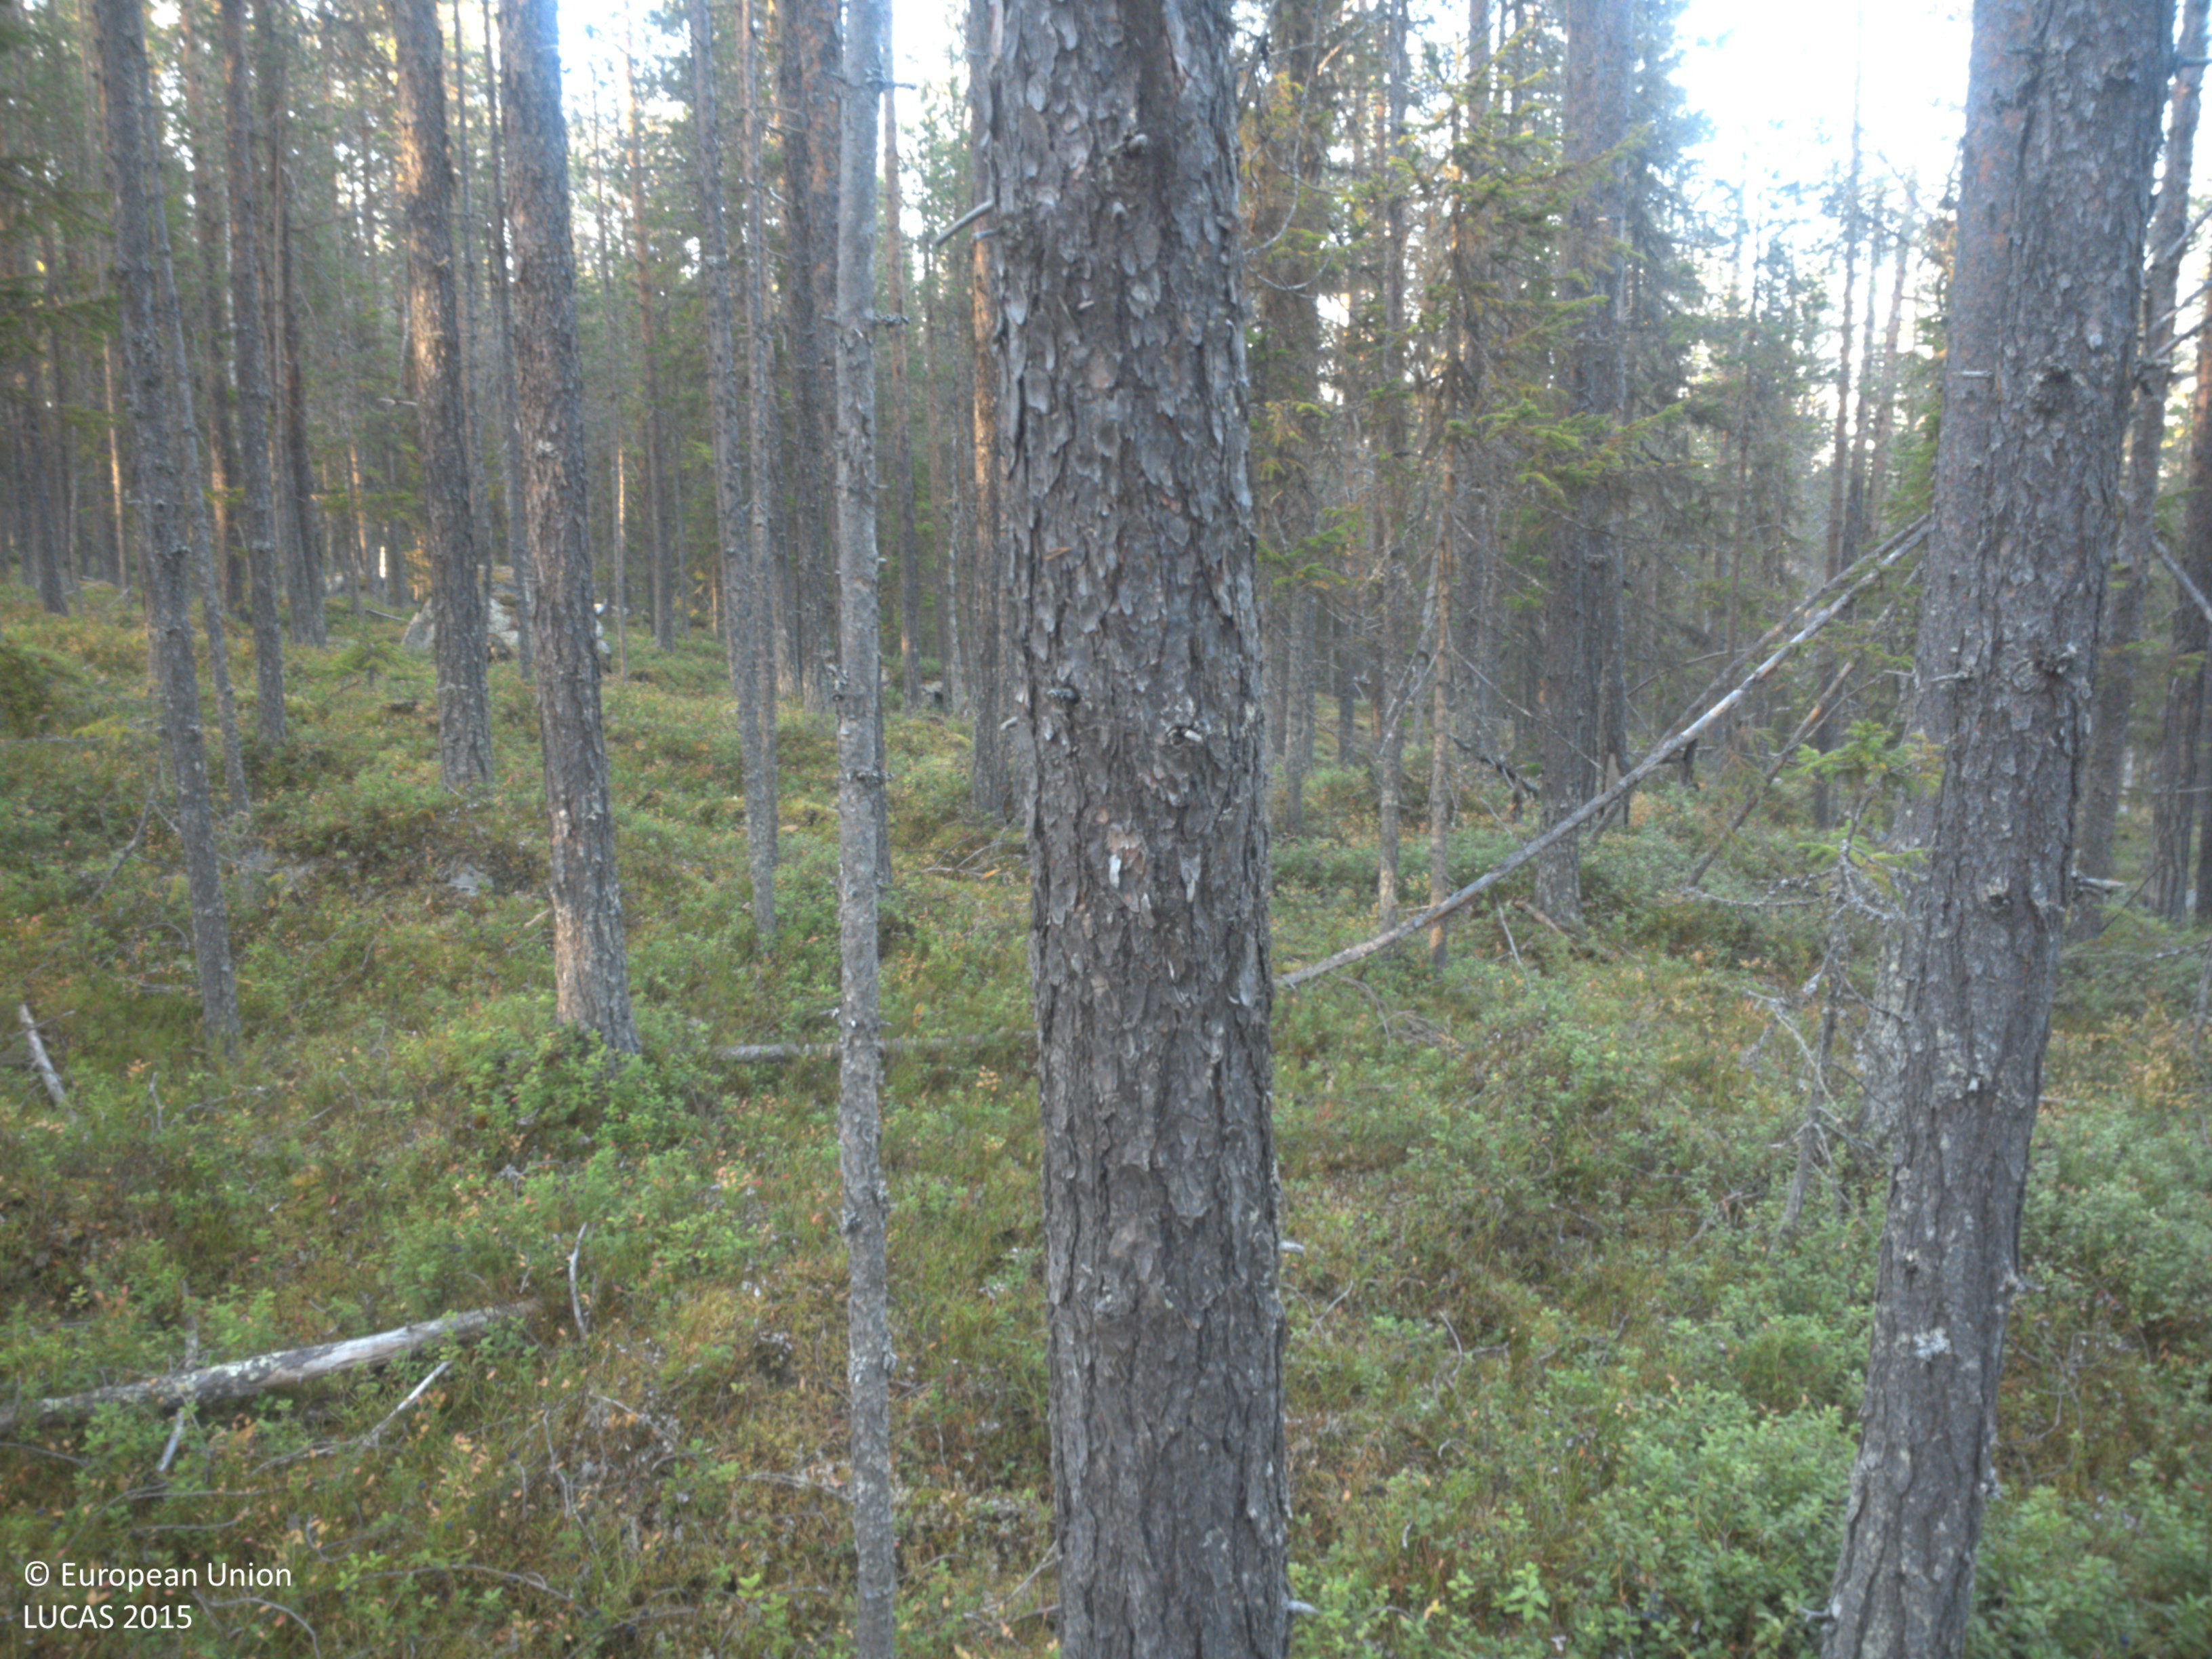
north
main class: Woodland
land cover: Pine dominated coniferous woodland
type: boreal forest
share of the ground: 50 - 75 %
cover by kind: coniferous forest trees 70 %, shrubs 25 %, lichens and mosses 5 %
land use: Forestry
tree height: > 5 m
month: October
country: SE
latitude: 64.8599
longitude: 18.1714
